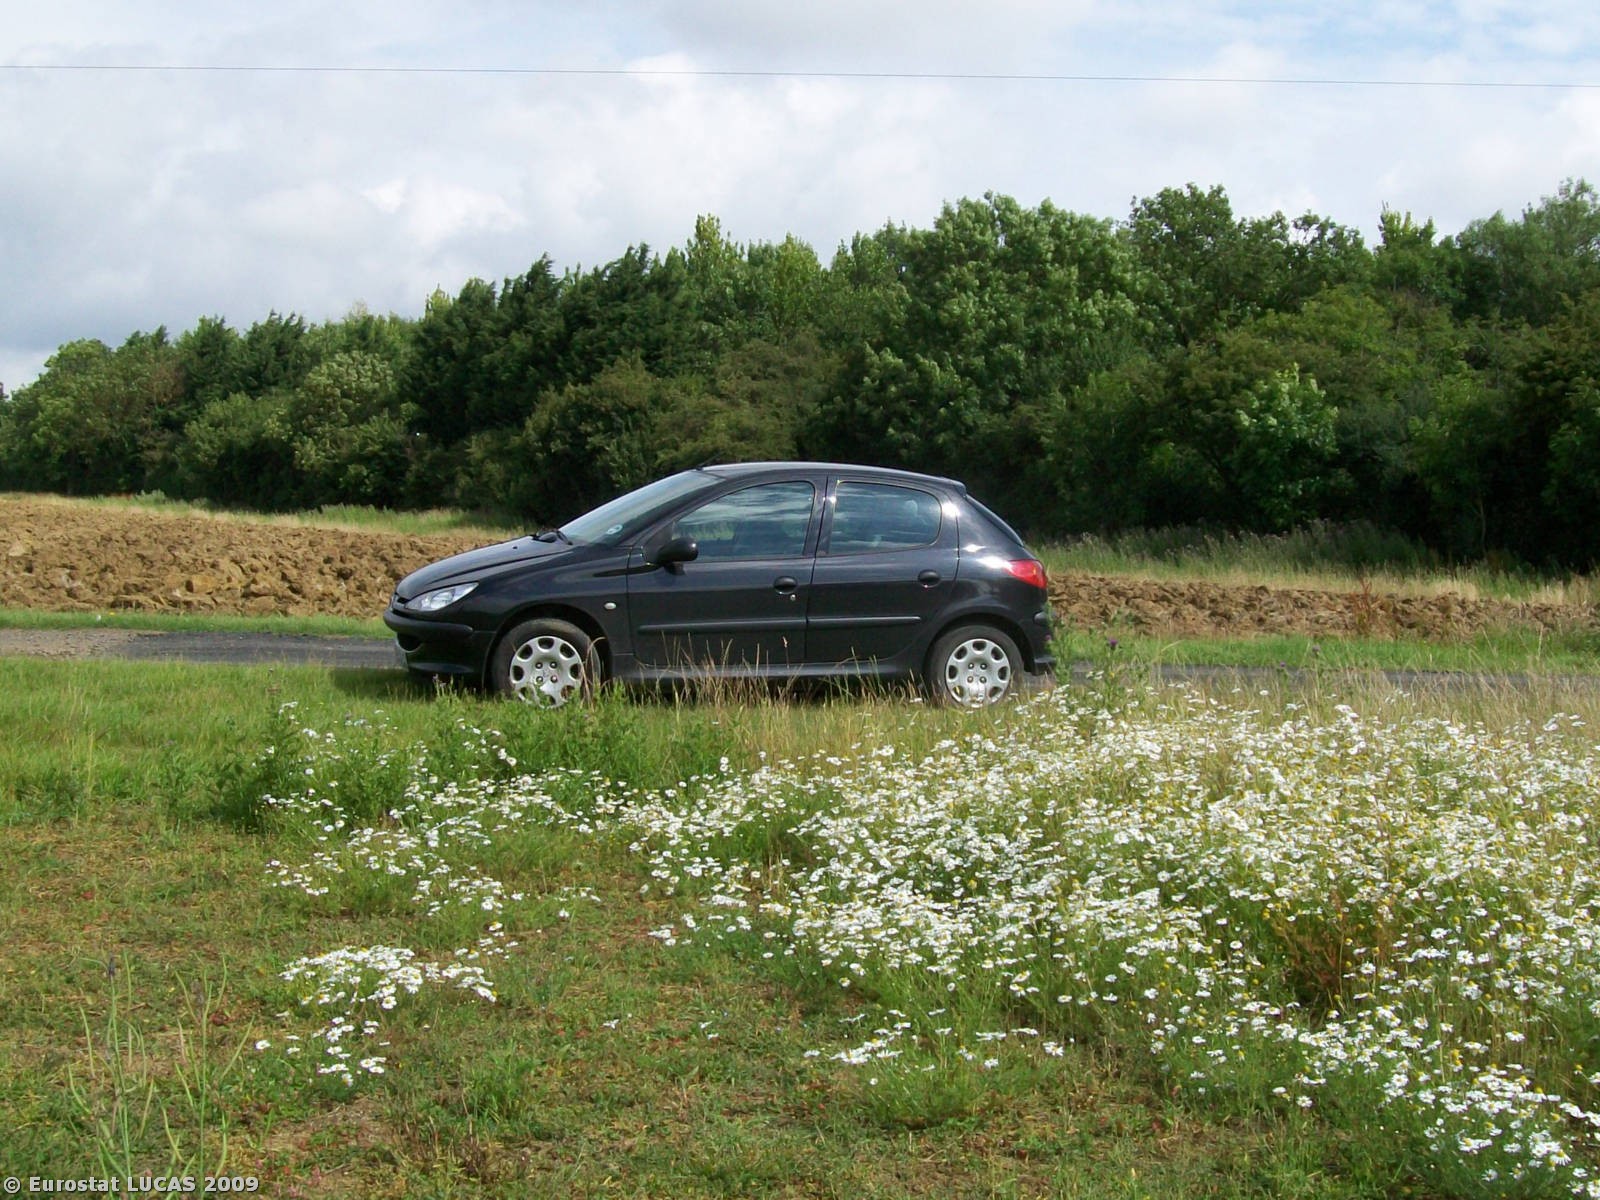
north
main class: Cropland
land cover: Rape and turnip rape
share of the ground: > 75 %
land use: Agriculture (excluding fallow land and kitchen gardens)
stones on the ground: < 10 %
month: July
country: GB
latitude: 52.2402
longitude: -1.2506
